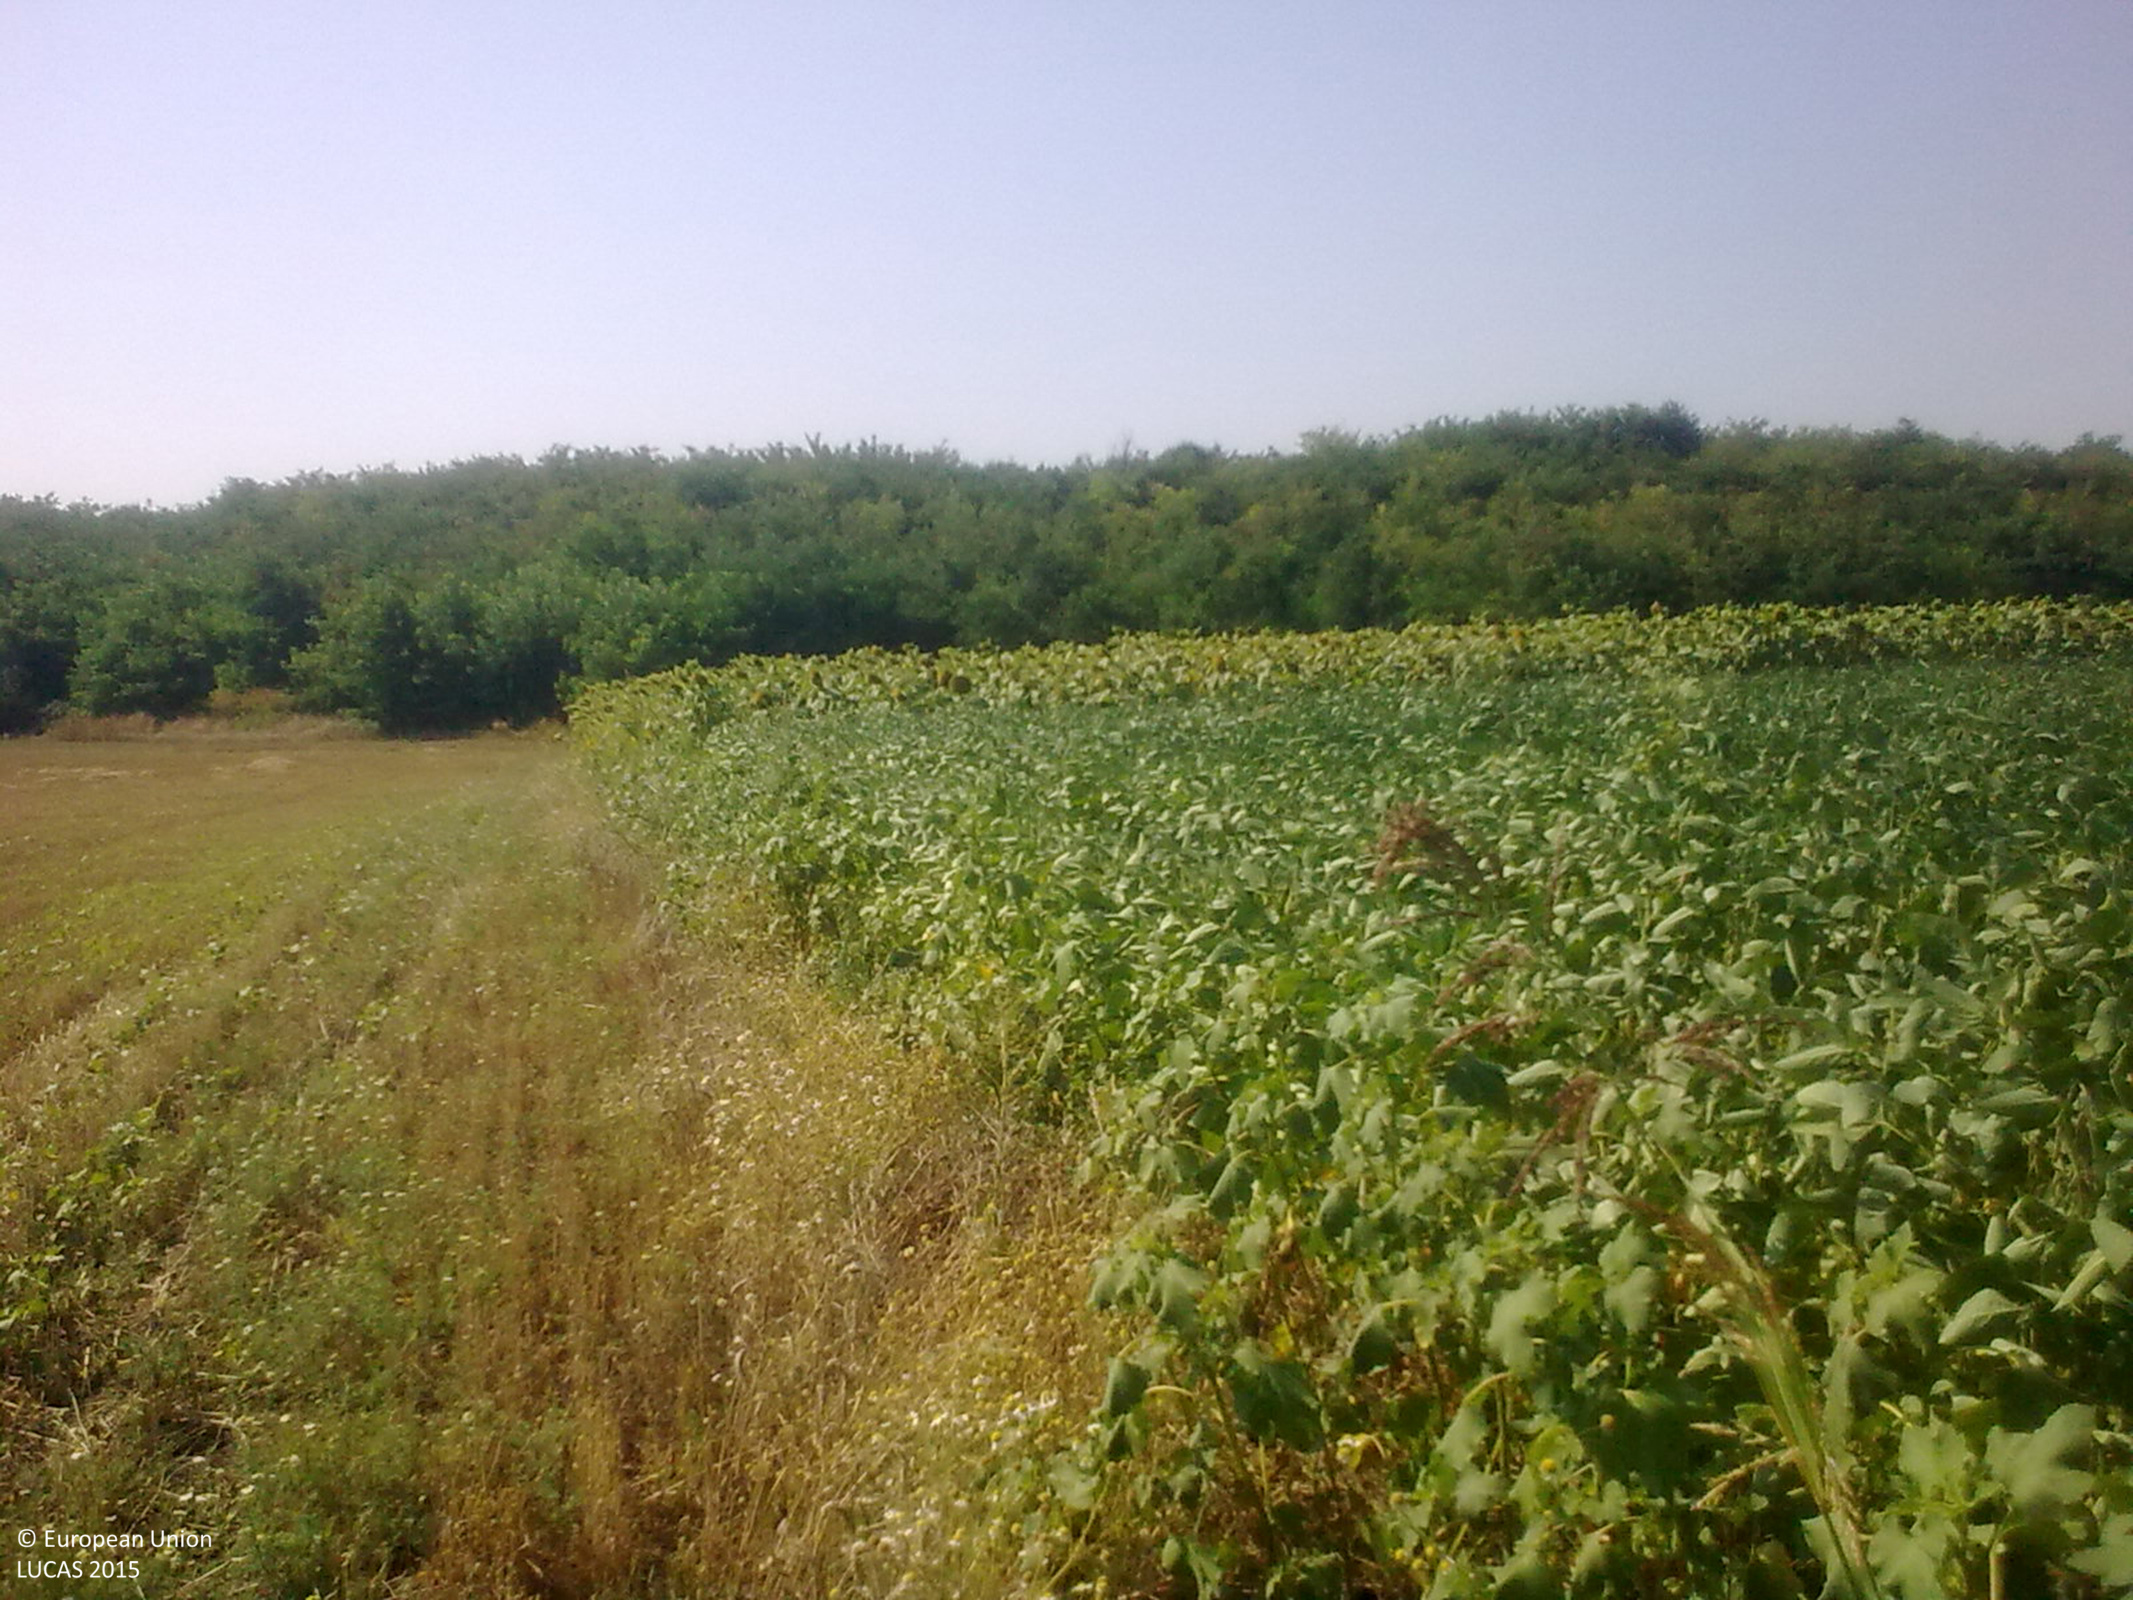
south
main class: Cropland
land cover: Soya
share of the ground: > 75 %
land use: Agriculture (excluding fallow land and kitchen gardens)
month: July
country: BG
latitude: 43.9196
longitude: 26.1542
